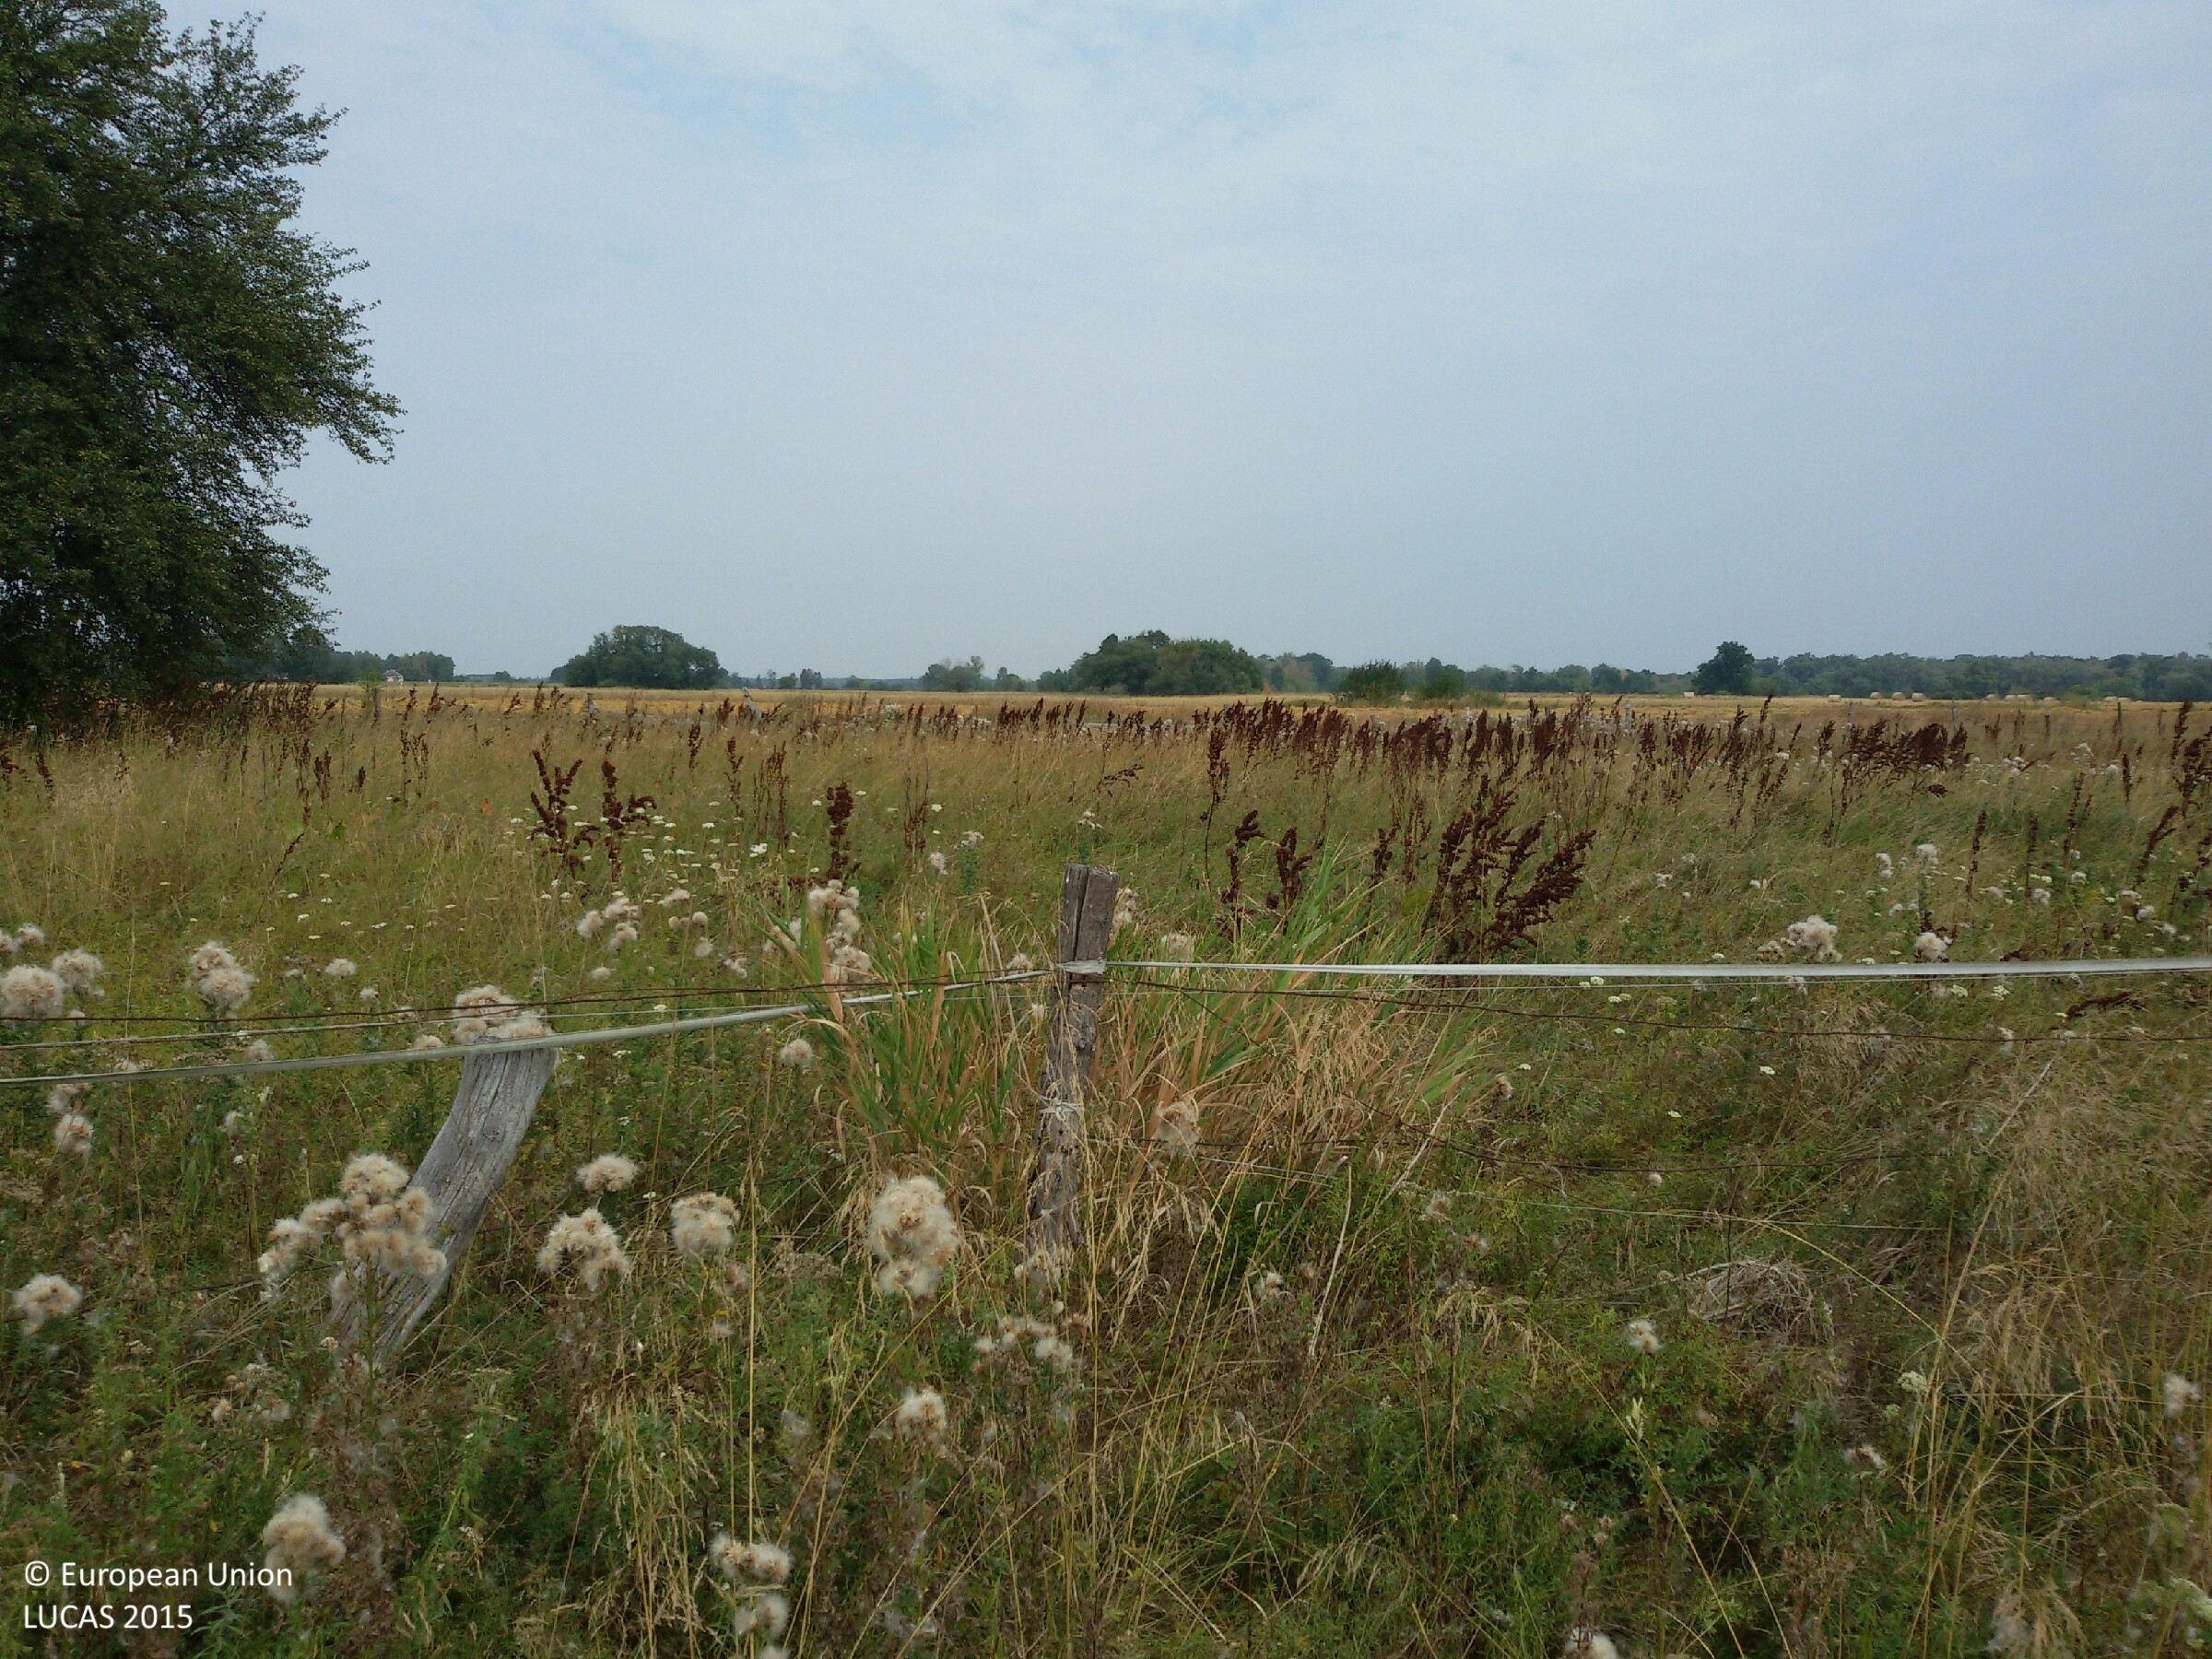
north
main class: Grassland
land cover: Spontaneously vegetated surfaces
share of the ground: > 75 %
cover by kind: herbaceous plants 100 %
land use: Fallow land
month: August
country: PL
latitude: 51.6339
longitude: 23.5363
